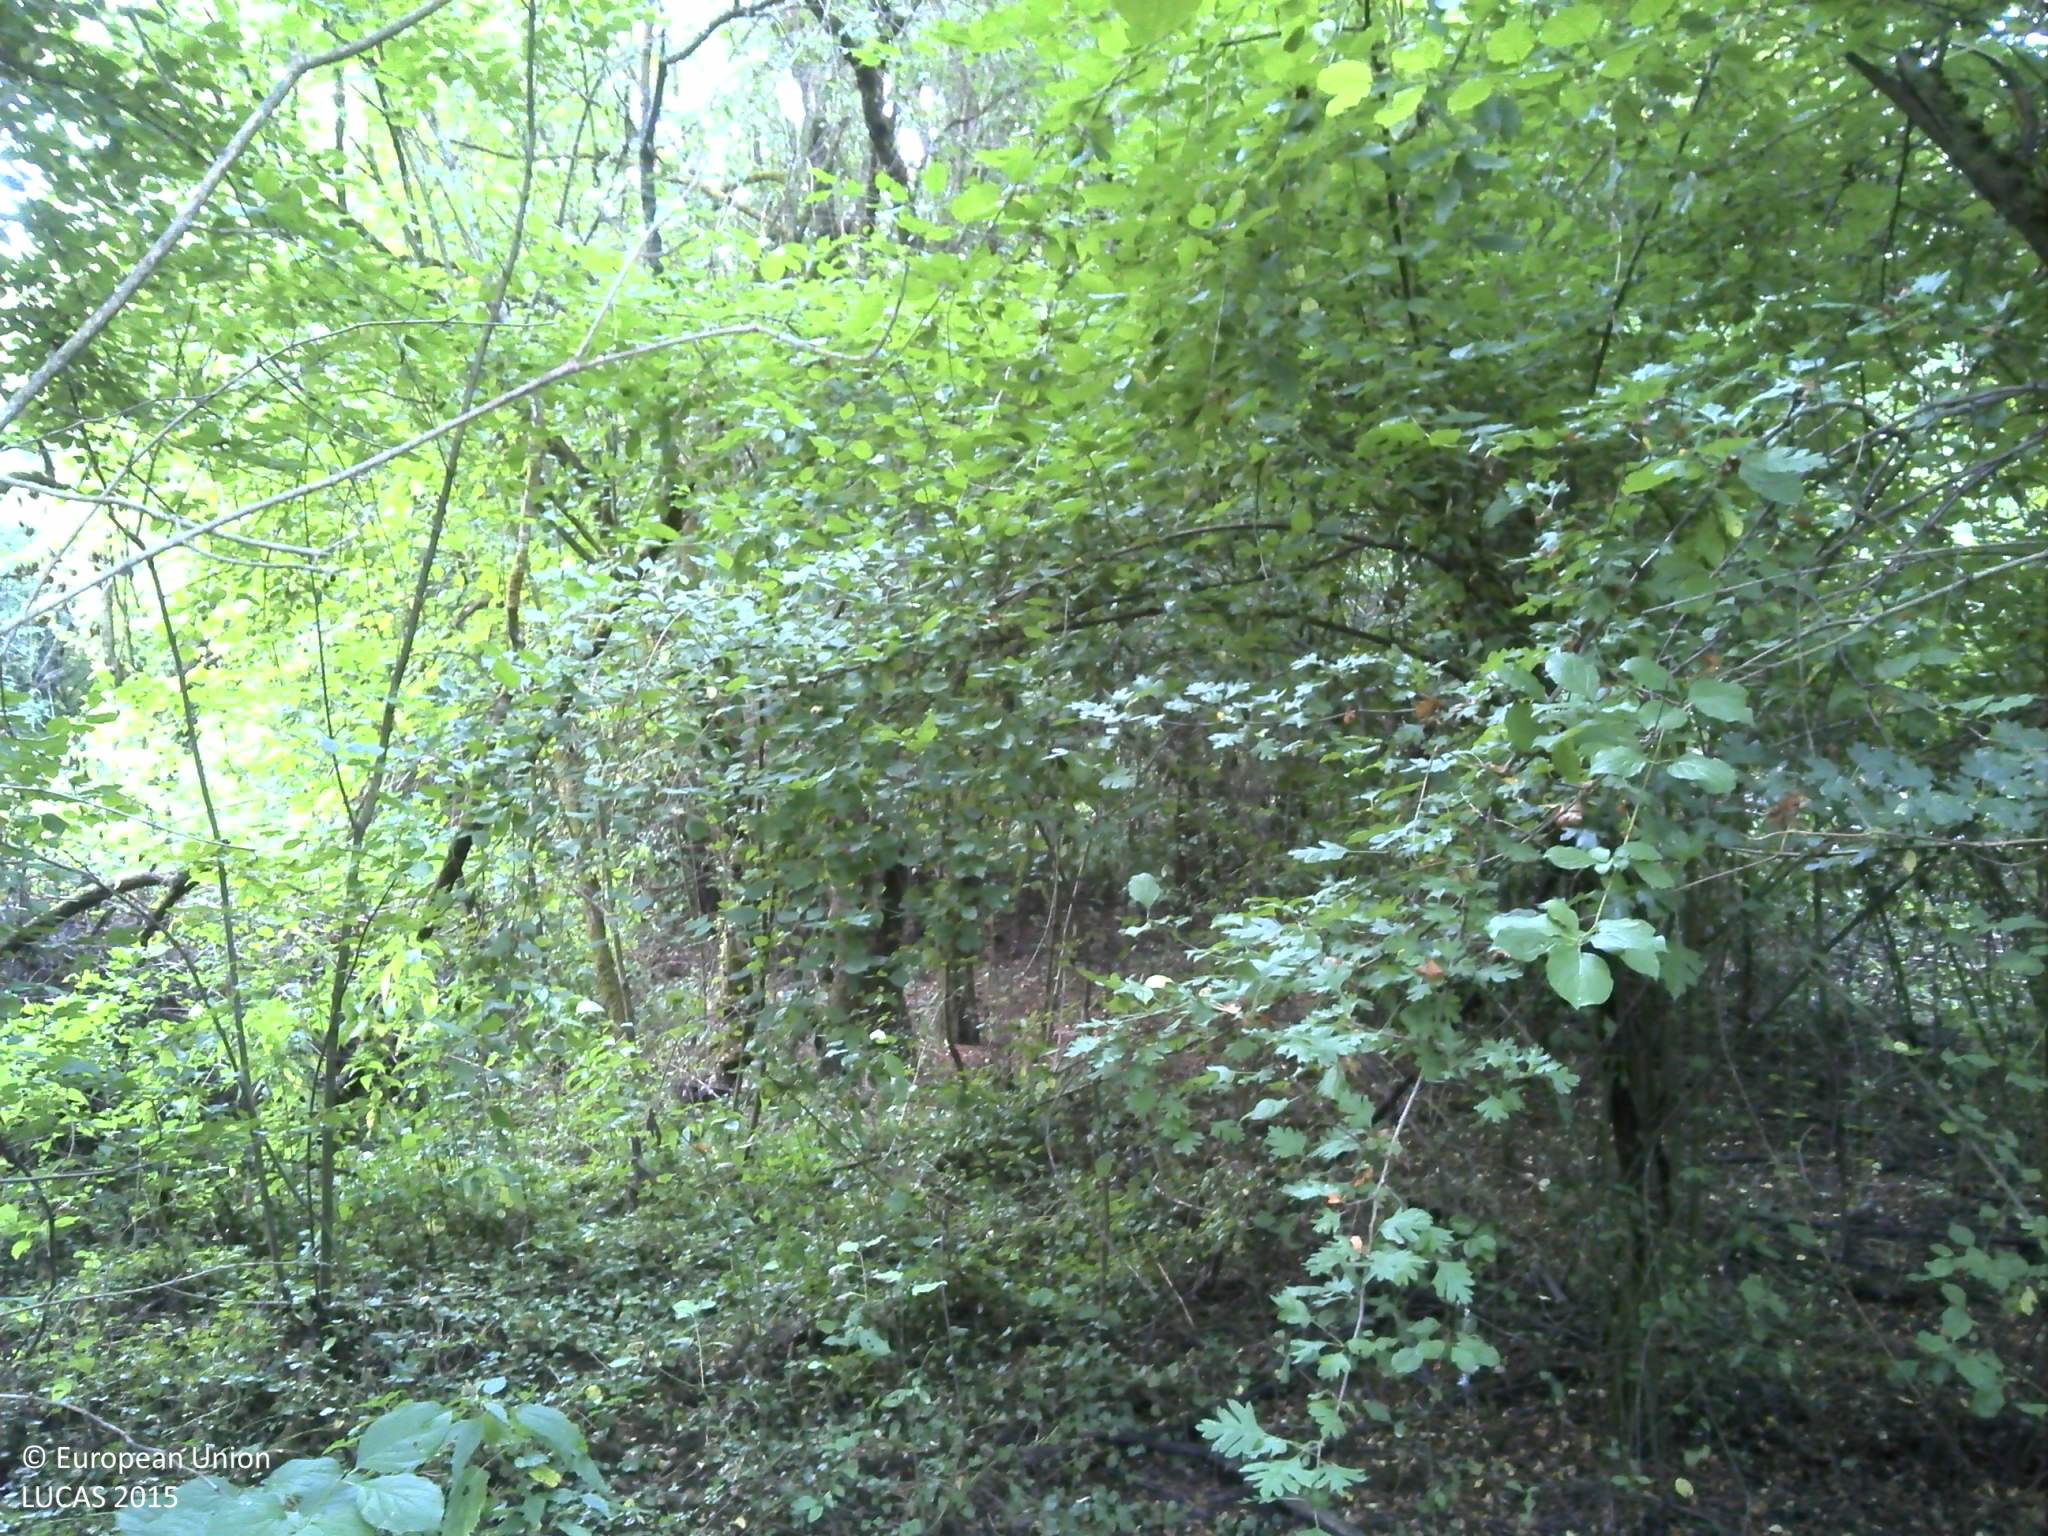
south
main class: Woodland
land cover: Broadleaved woodland
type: acidophilous oak and oak-birch forest
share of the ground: 10 - 25 %
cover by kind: shrubs 80 %, broadleaved forest trees 20 %
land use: Forestry
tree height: > 5 m
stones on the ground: < 10 %
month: August
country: HR
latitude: 45.3430
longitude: 18.0307
